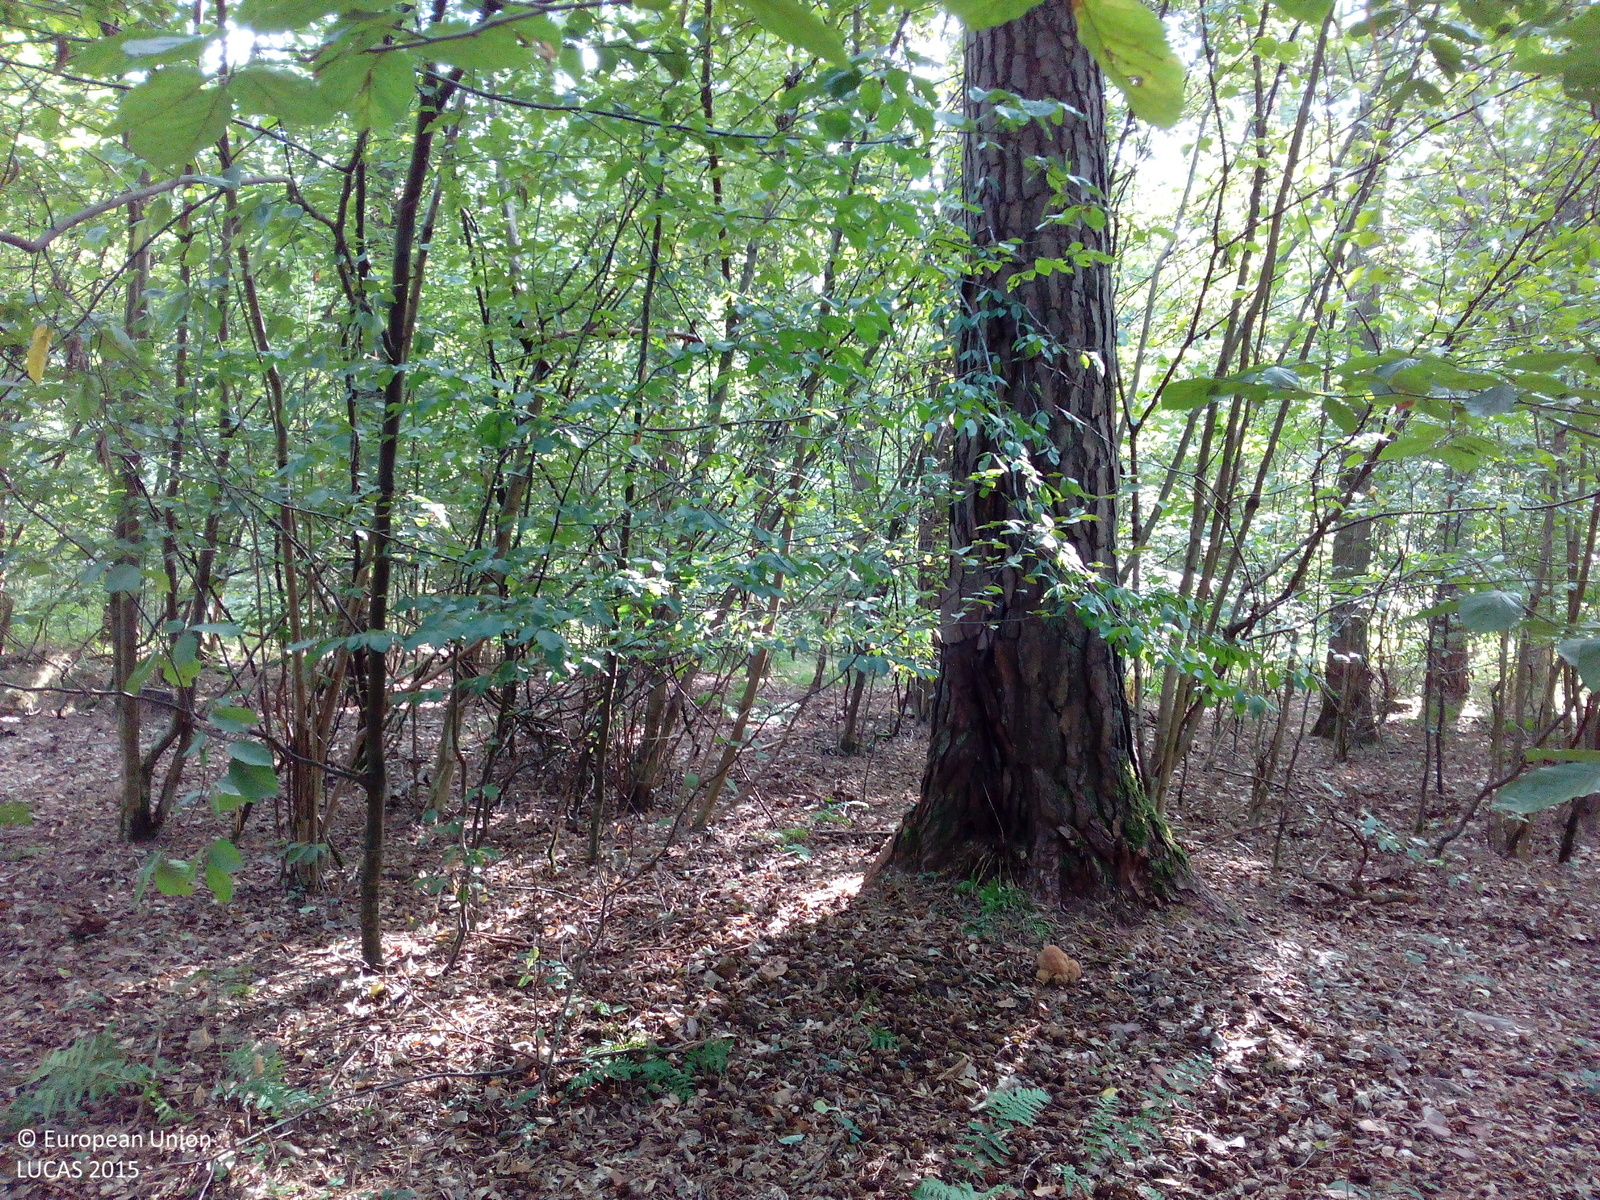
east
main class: Woodland
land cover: Pine dominated mixed woodland
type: hemiboreal forest and nemoral coniferous forest and mixed broadleaved-coniferous forest
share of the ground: > 75 %
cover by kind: broadleaved forest trees 55 %, coniferous forest trees 40 %, herbaceous plants 5 %
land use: Forestry
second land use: Amenities, museums, leisure
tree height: > 5 m
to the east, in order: Pine dominated mixed woodland; Tracks; Pine dominated mixed woodland; Broadleaved woodland; Rivers and streams; Broadleaved woodland; Pine dominated mixed woodland; Ditches and canals; Tracks; Broadleaved woodland
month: September
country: DE
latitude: 49.7878
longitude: 9.5696
